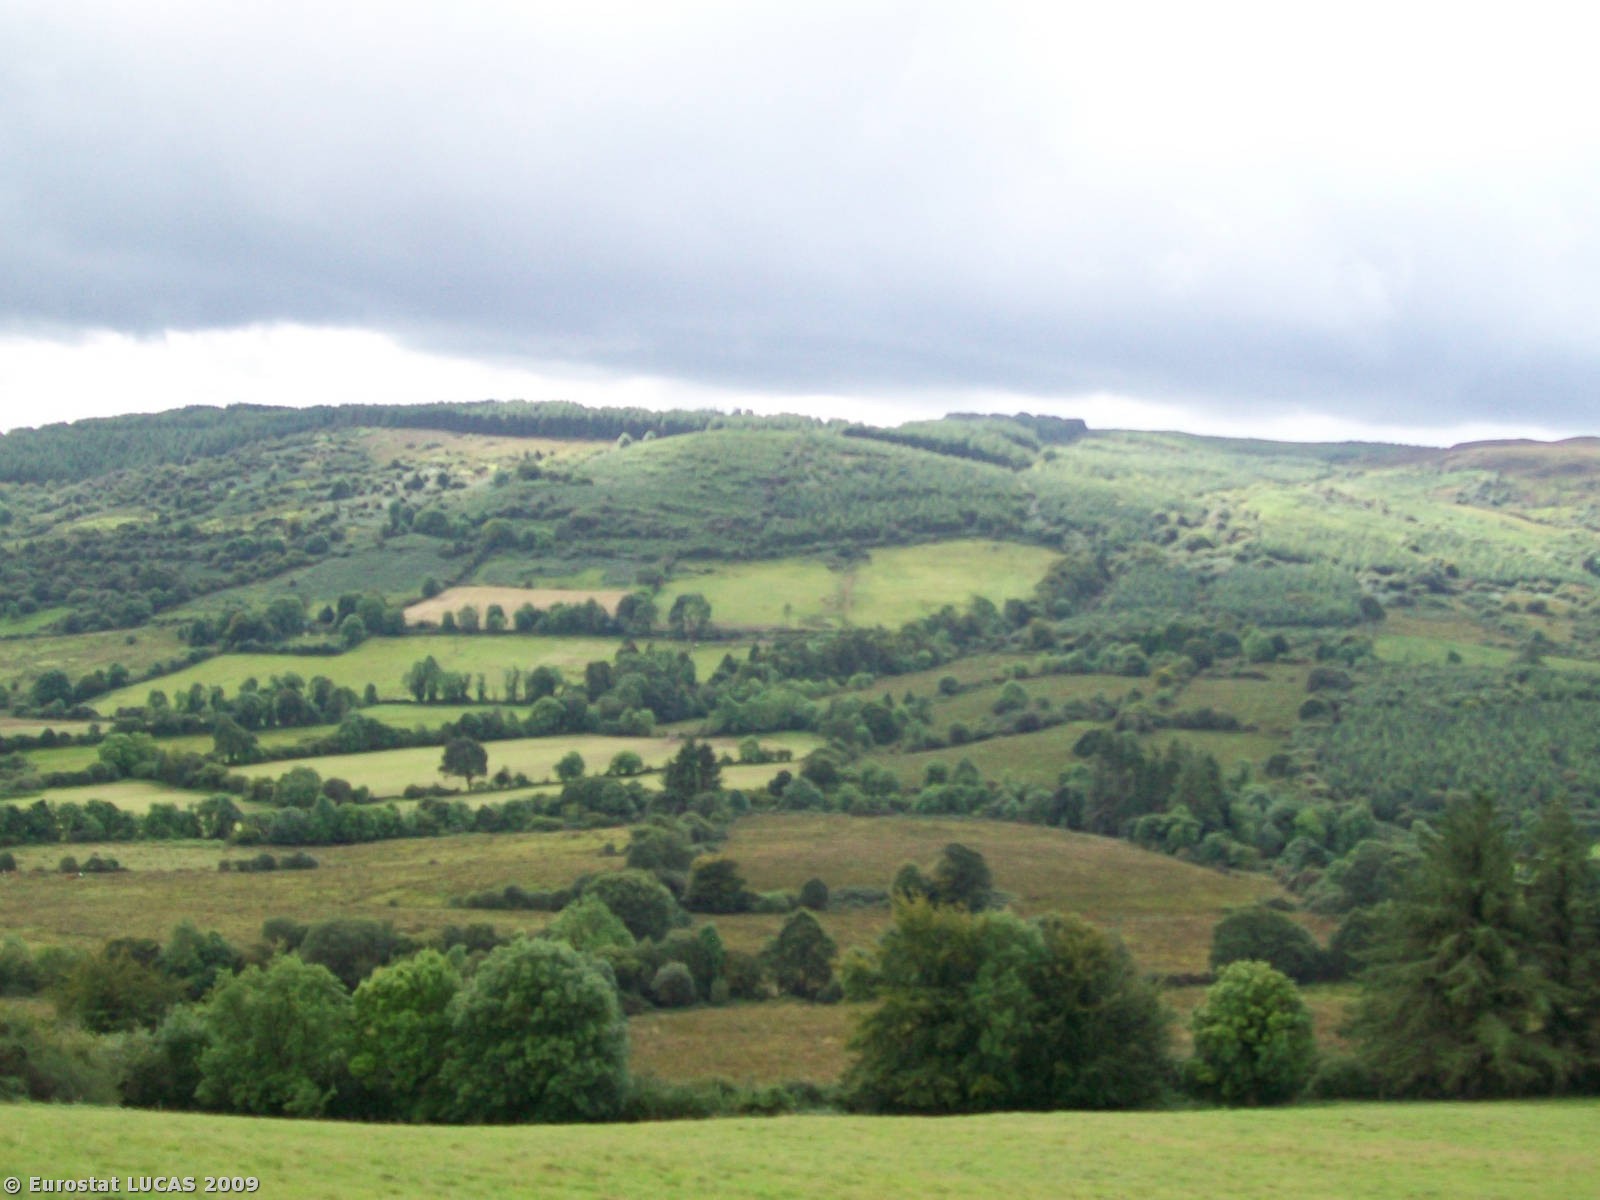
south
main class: Grassland
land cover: Grassland without tree/shrub cover
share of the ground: > 75 %
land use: Agriculture (excluding fallow land and kitchen gardens)
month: August
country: IE
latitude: 52.9645
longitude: -8.6769
